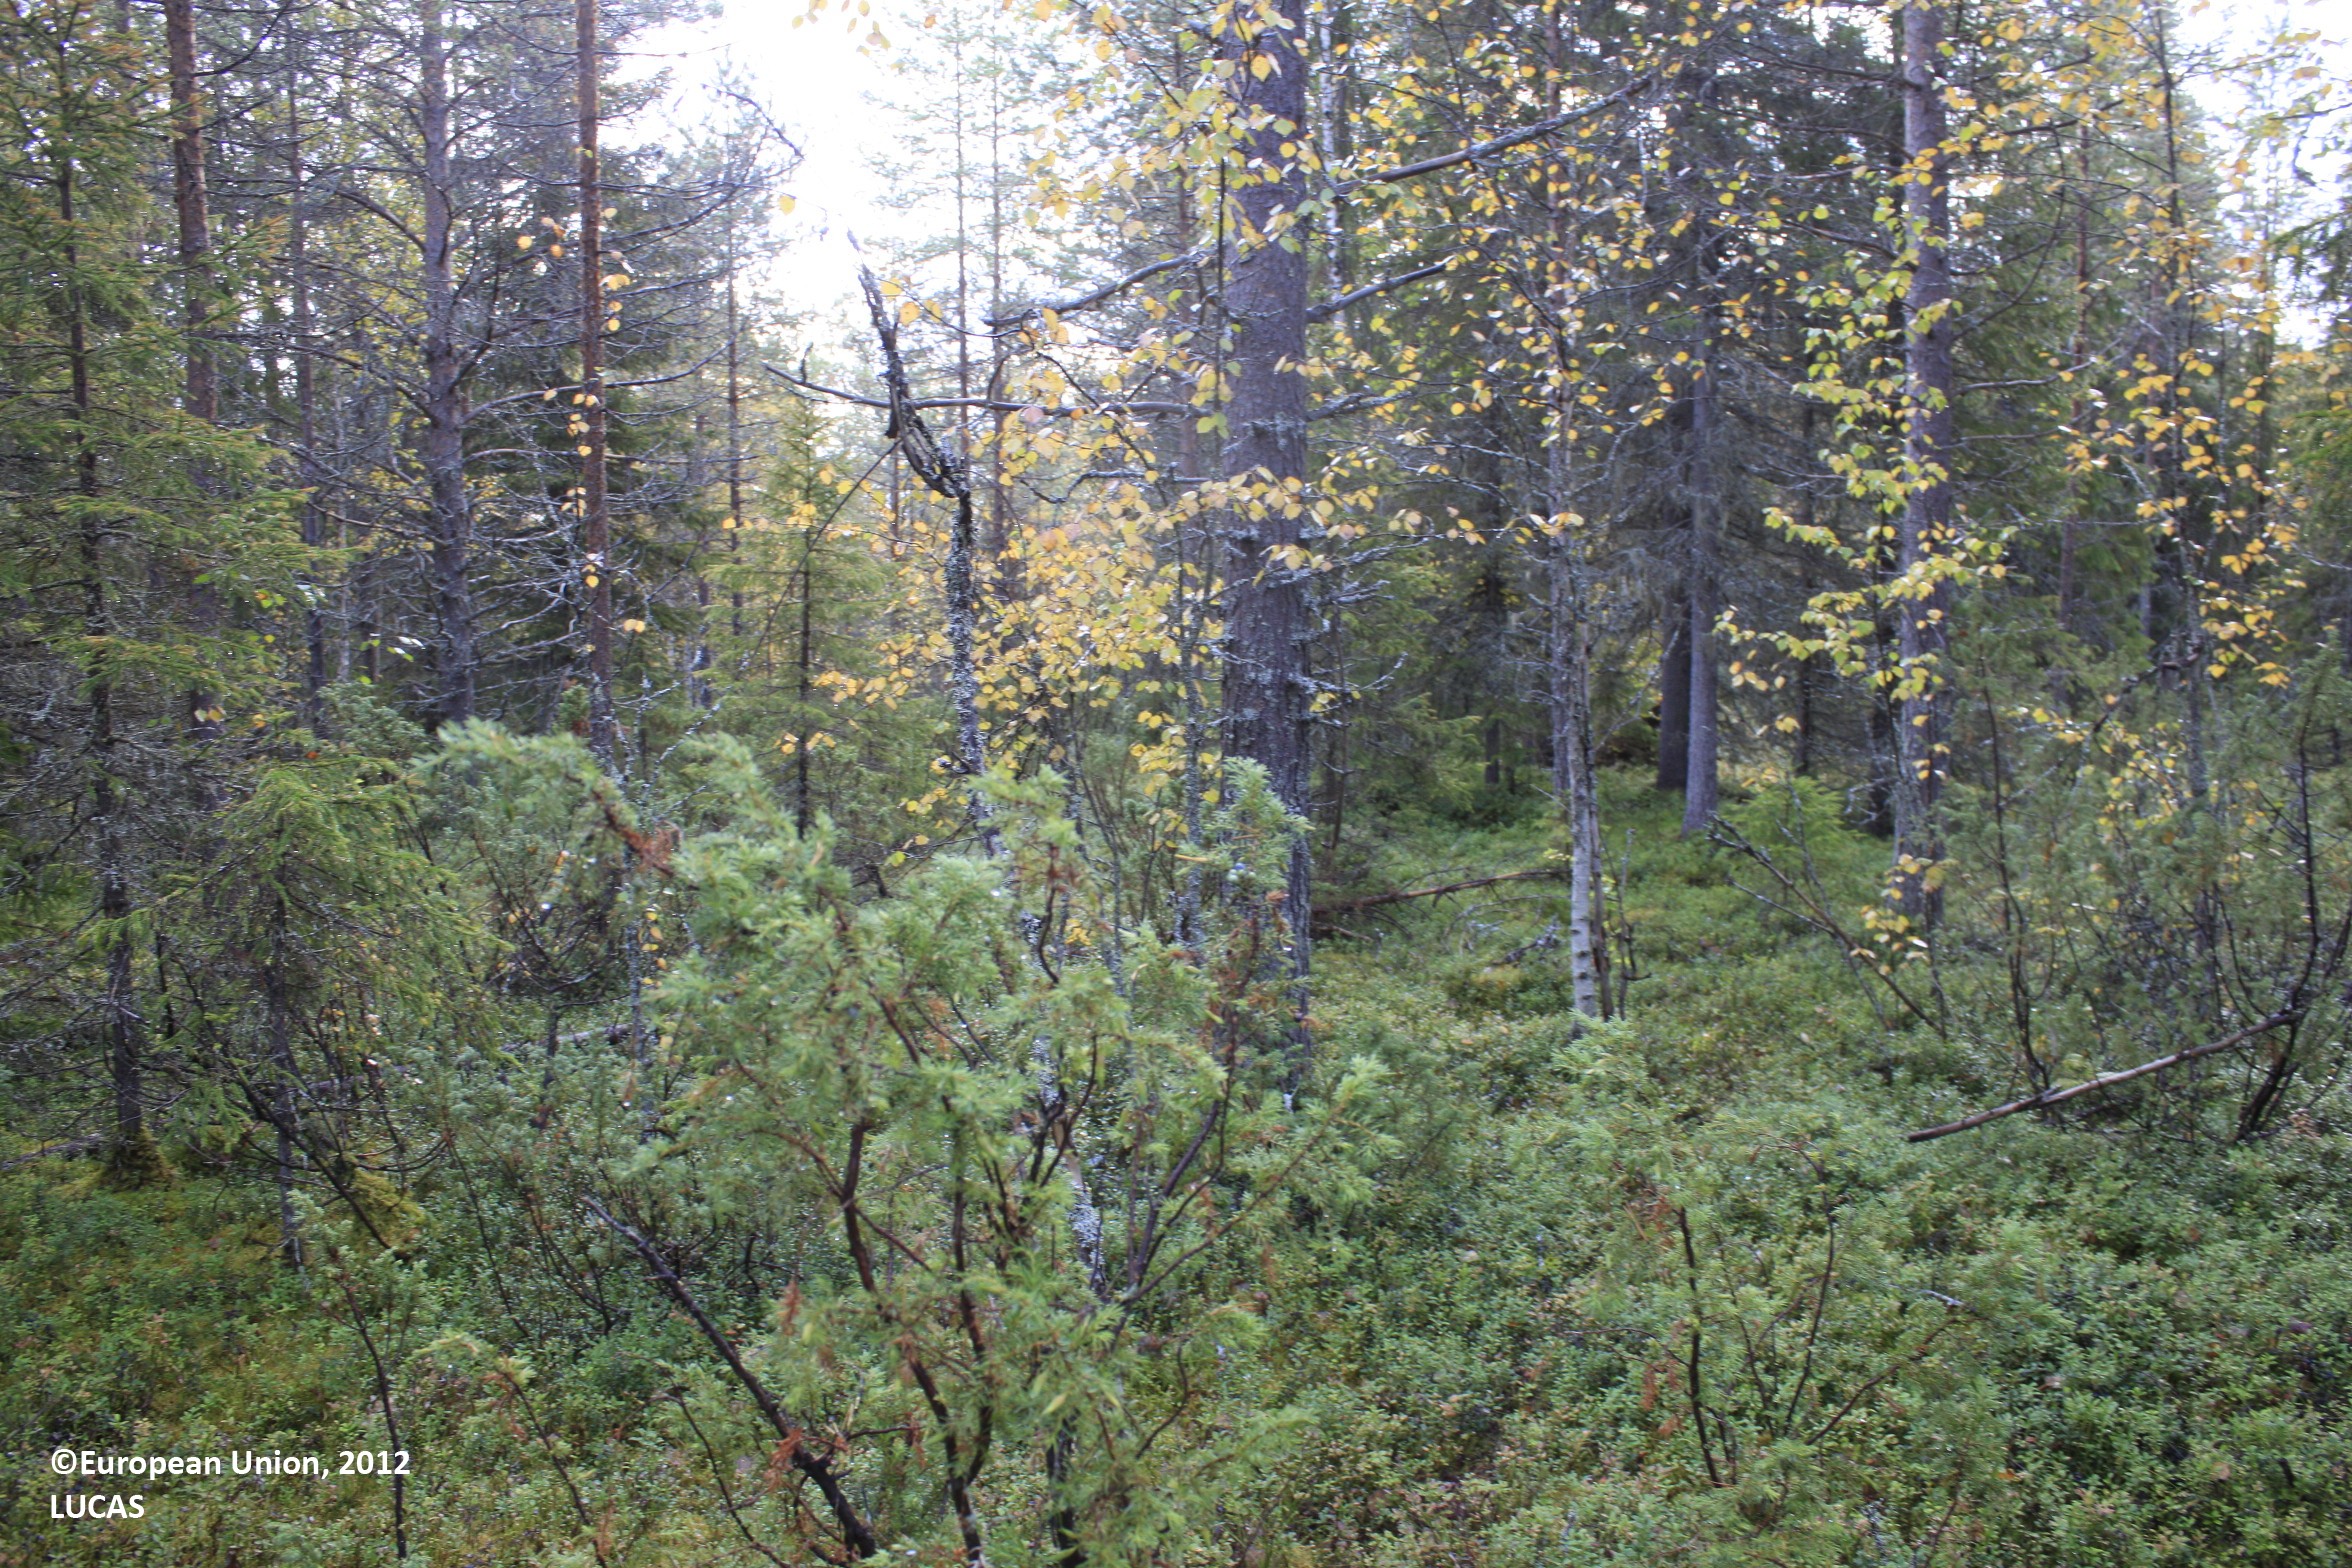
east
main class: Woodland
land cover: Pine dominated mixed woodland
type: boreal forest
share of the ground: 25 - 50 %
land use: Forestry
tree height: > 5 m
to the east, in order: Pine dominated mixed woodland; Ditches and canals; Pine dominated mixed woodland
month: September
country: FI
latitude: 65.6367
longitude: 26.7249
